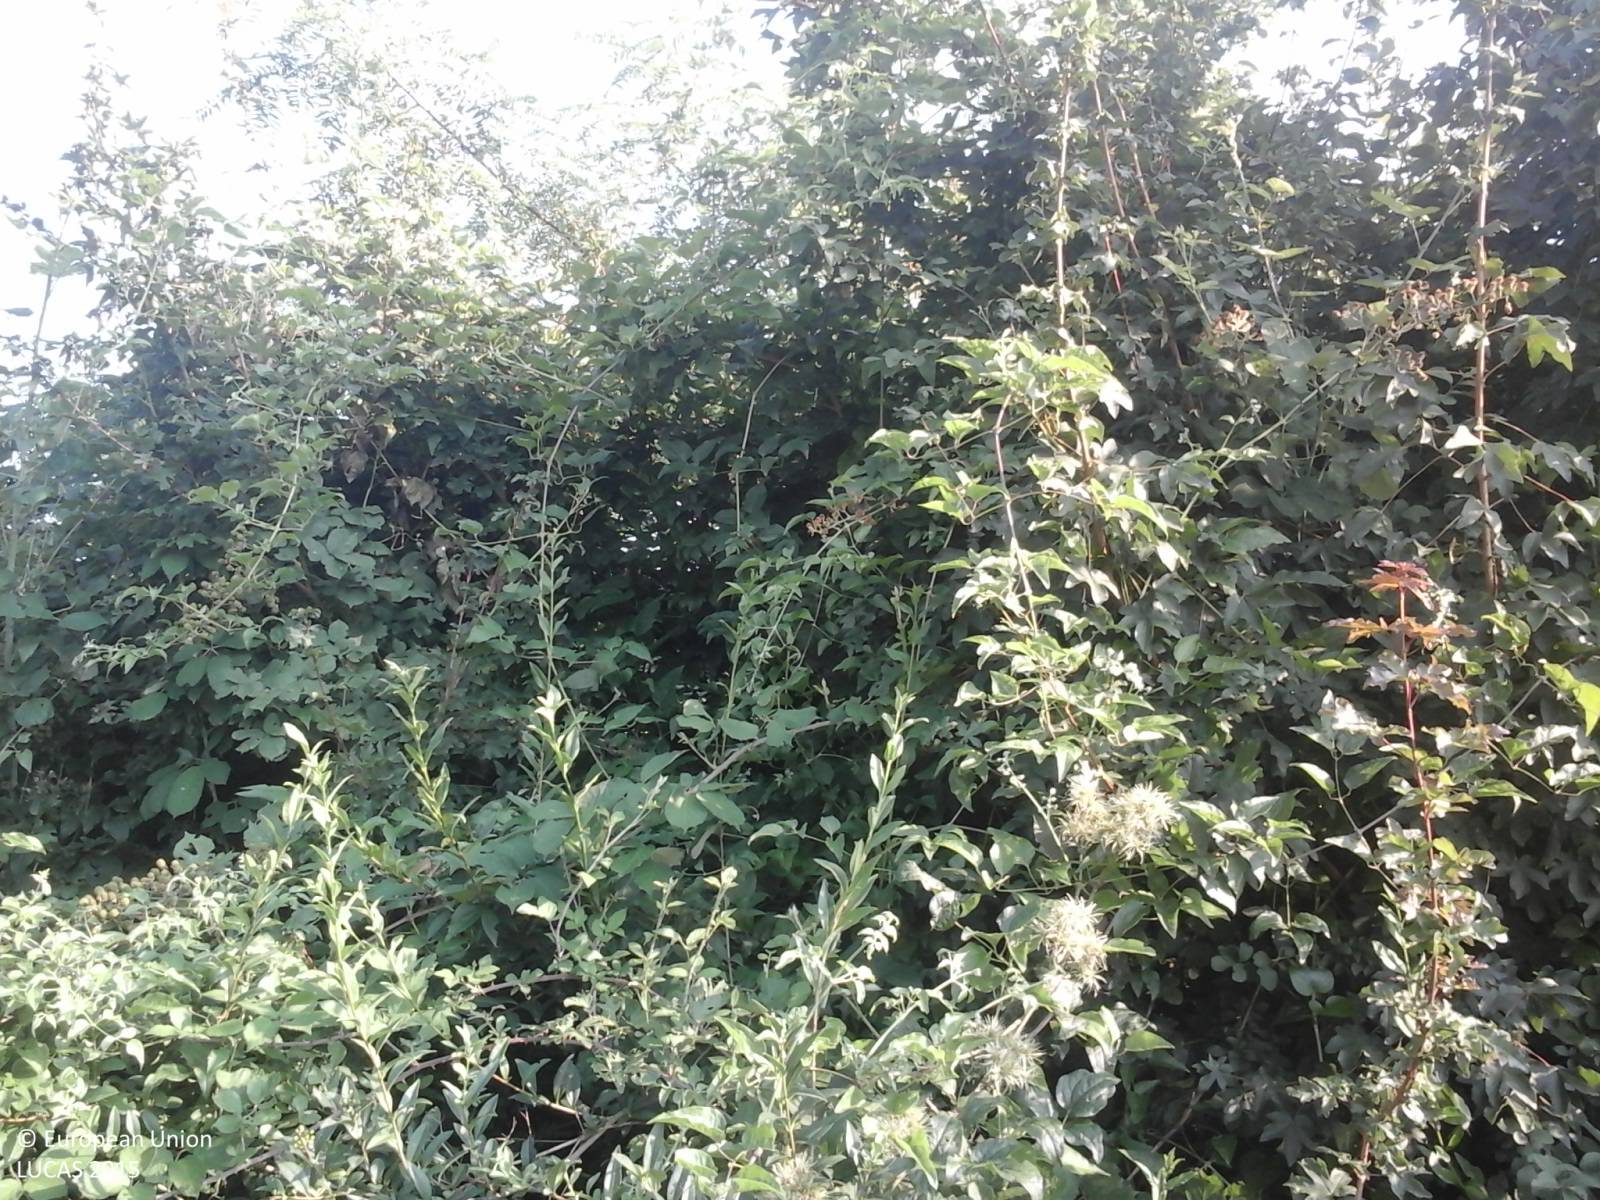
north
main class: Woodland
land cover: Broadleaved woodland
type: thermophilous deciduous forest
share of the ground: > 75 %
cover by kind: broadleaved forest trees 60 %, shrubs 40 %
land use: Forestry
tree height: > 5 m
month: July
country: IT
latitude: 46.1091
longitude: 13.0628
